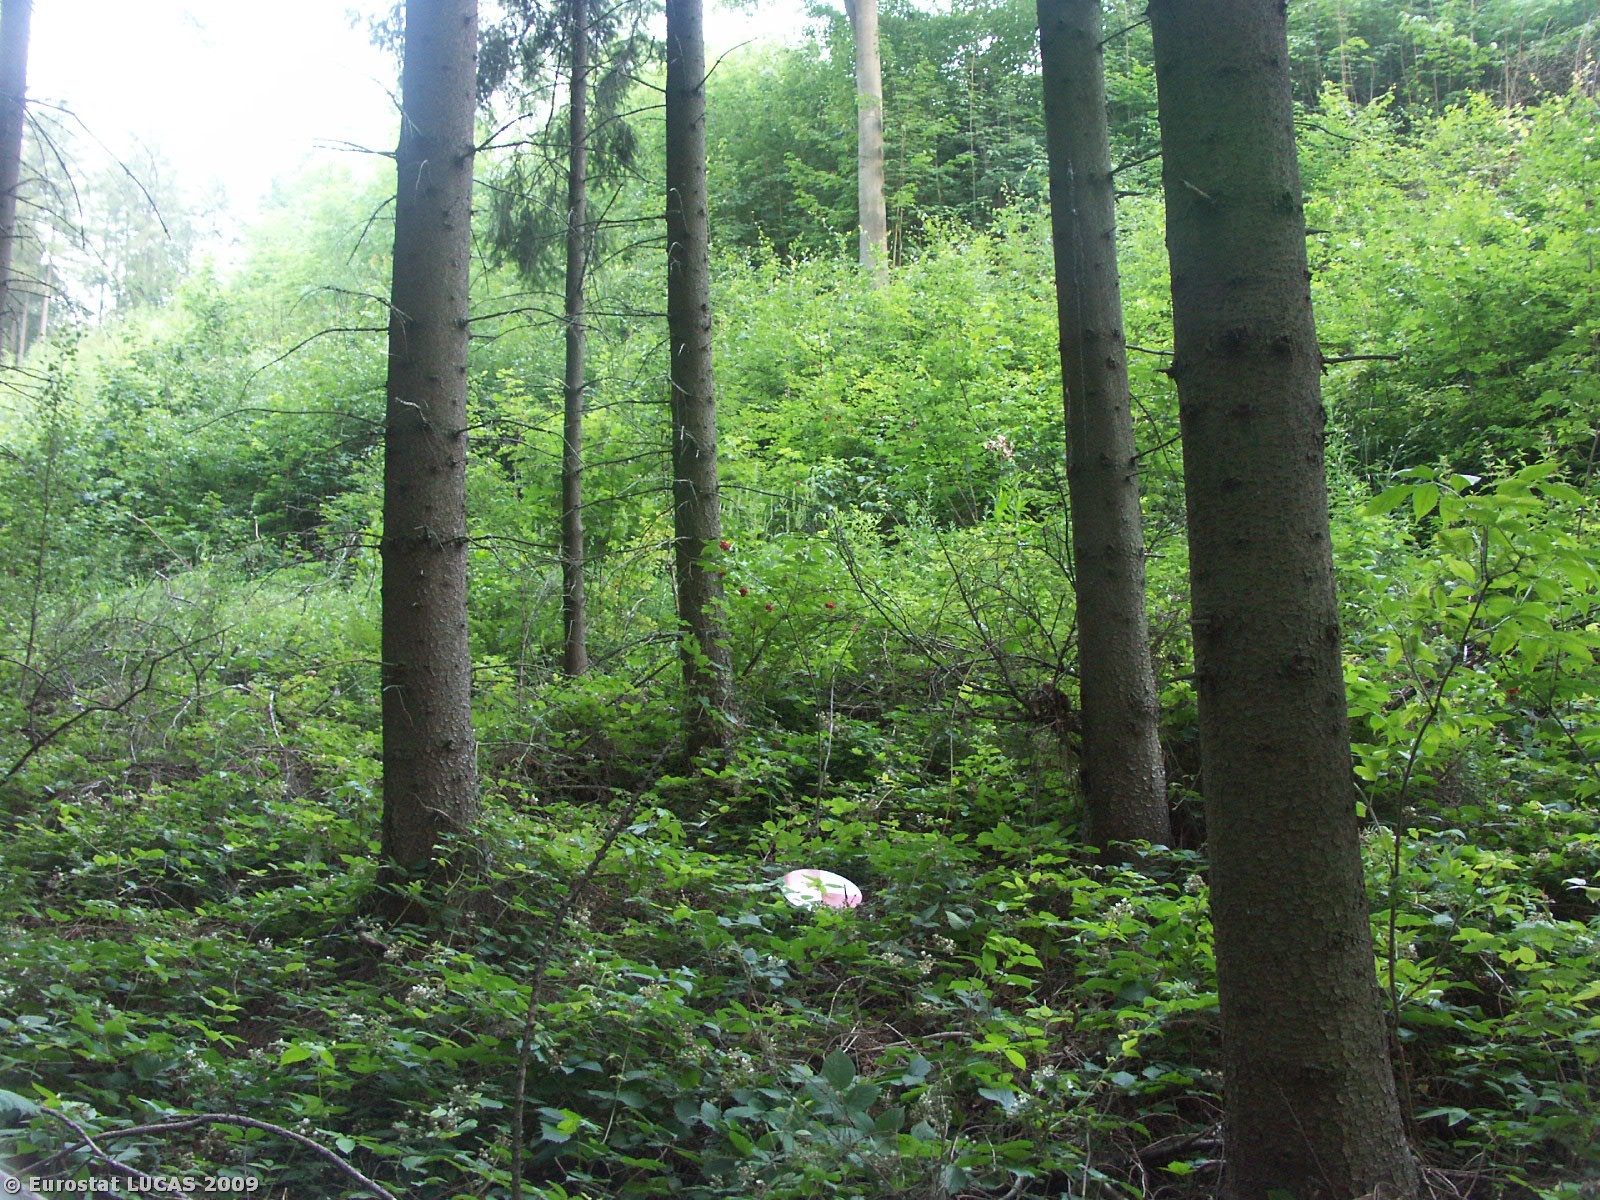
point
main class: Woodland
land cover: Coniferous woodland
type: hemiboreal forest and nemoral coniferous forest and mixed broadleaved-coniferous forest
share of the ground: > 75 %
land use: Forestry
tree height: > 5 m
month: July
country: CZ
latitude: 49.9357
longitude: 16.6539
